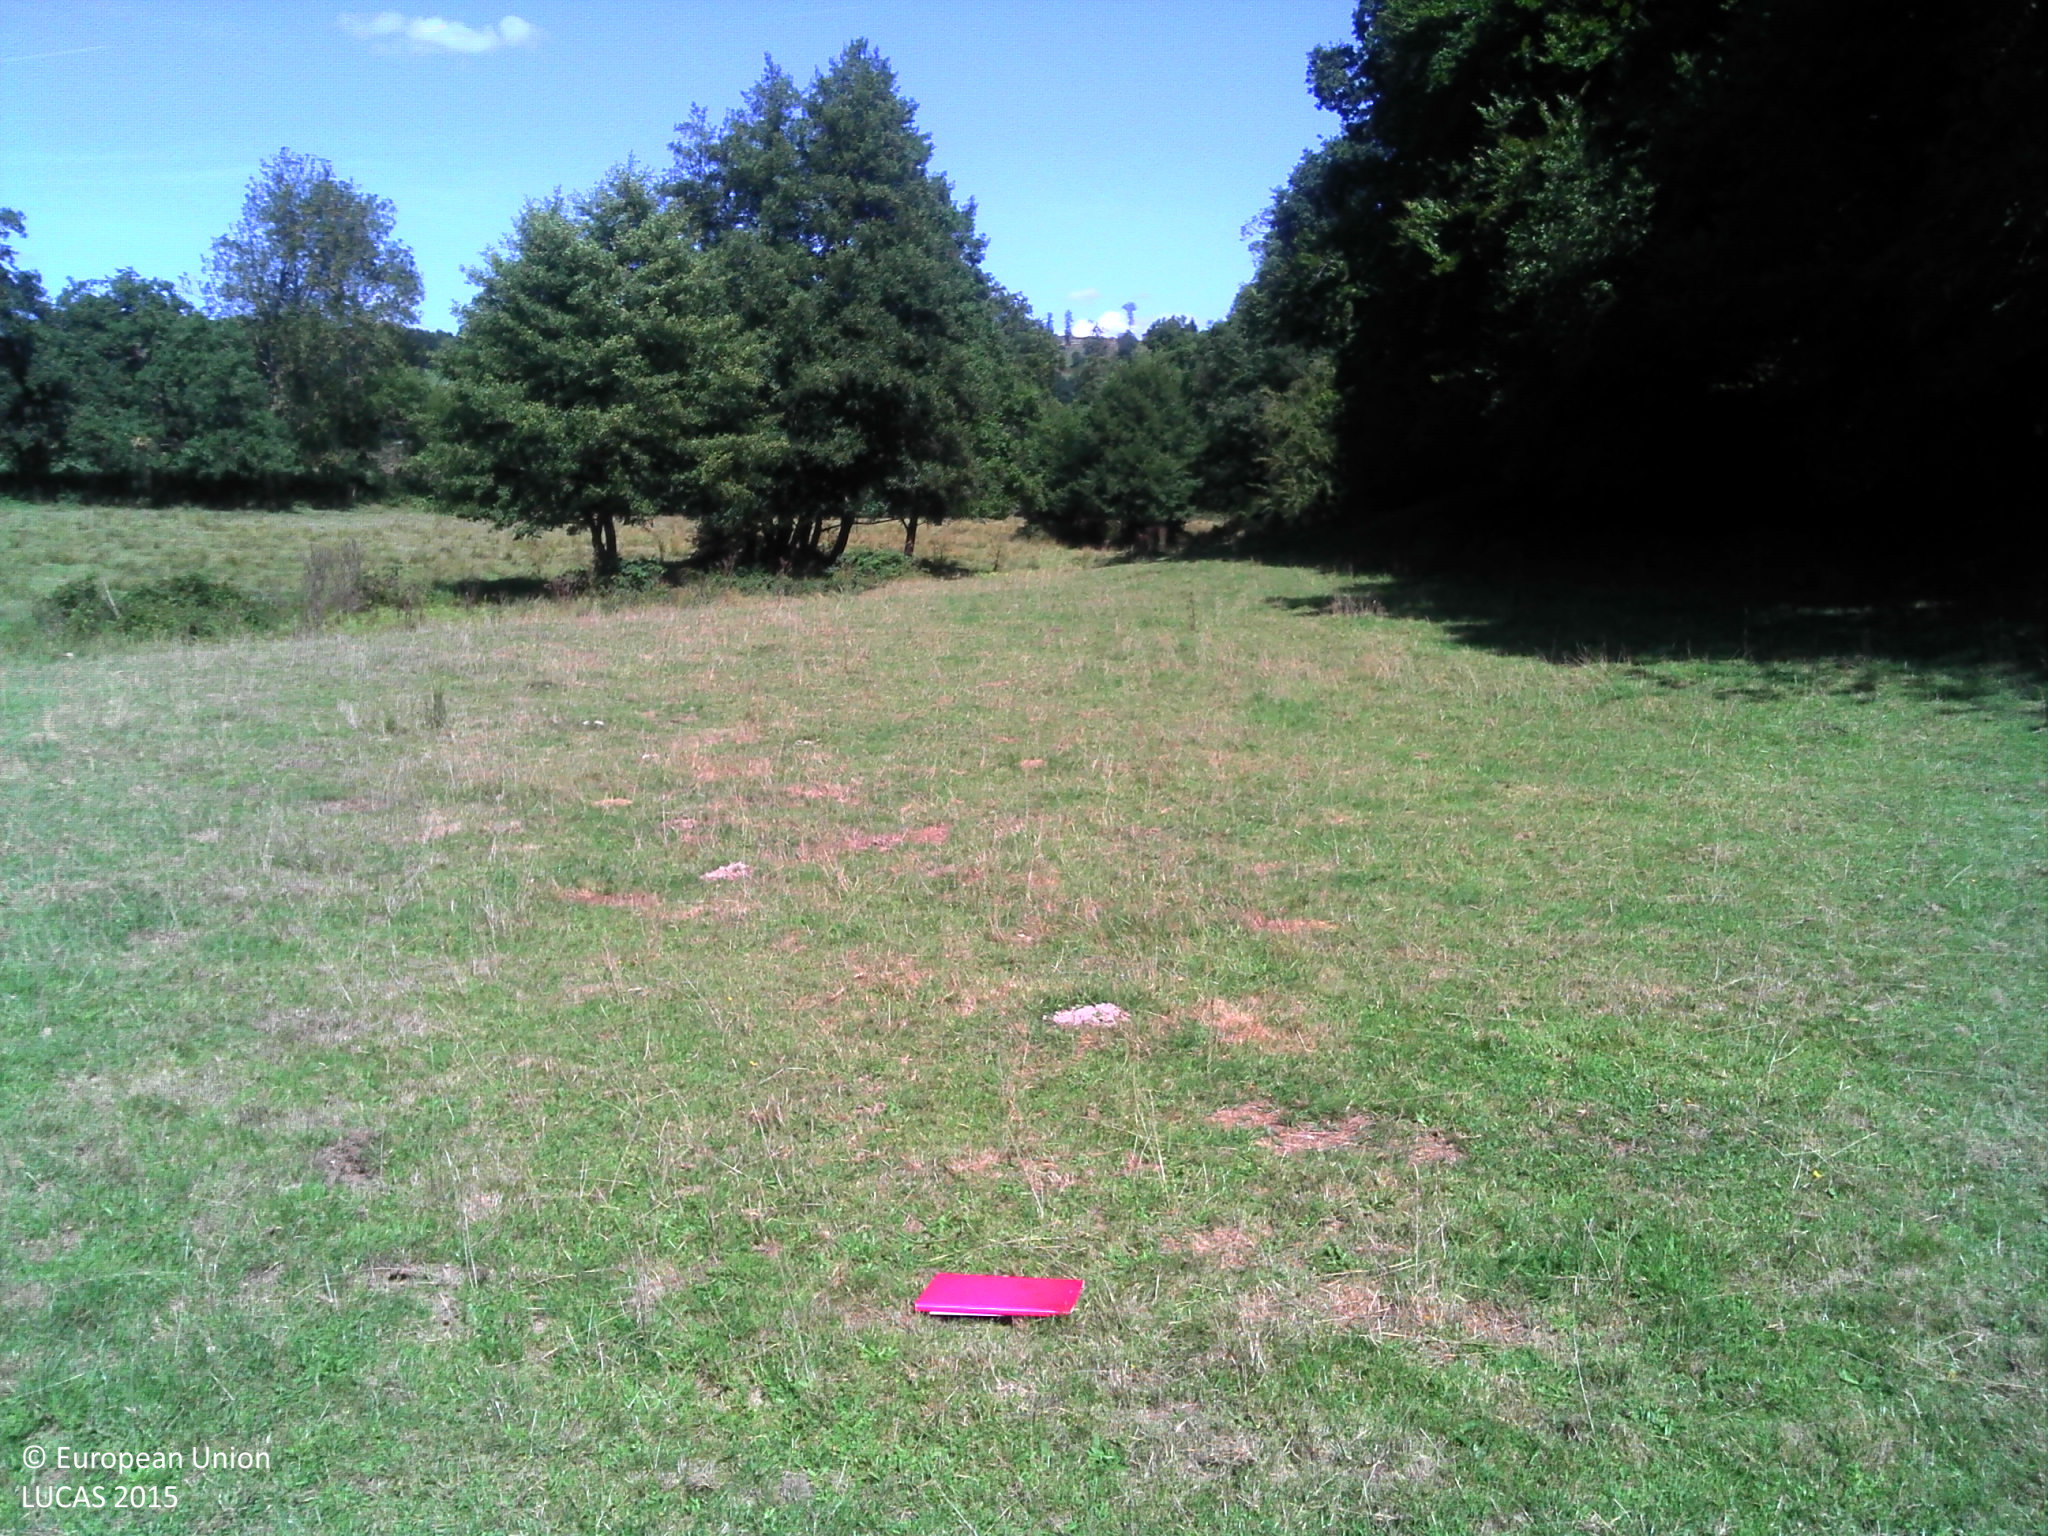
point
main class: Grassland
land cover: Grassland without tree/shrub cover
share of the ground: > 75 %
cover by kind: herbaceous plants 100 %
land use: Agriculture (excluding fallow land and kitchen gardens)
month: August
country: FR
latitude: 45.8710
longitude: 2.2537
